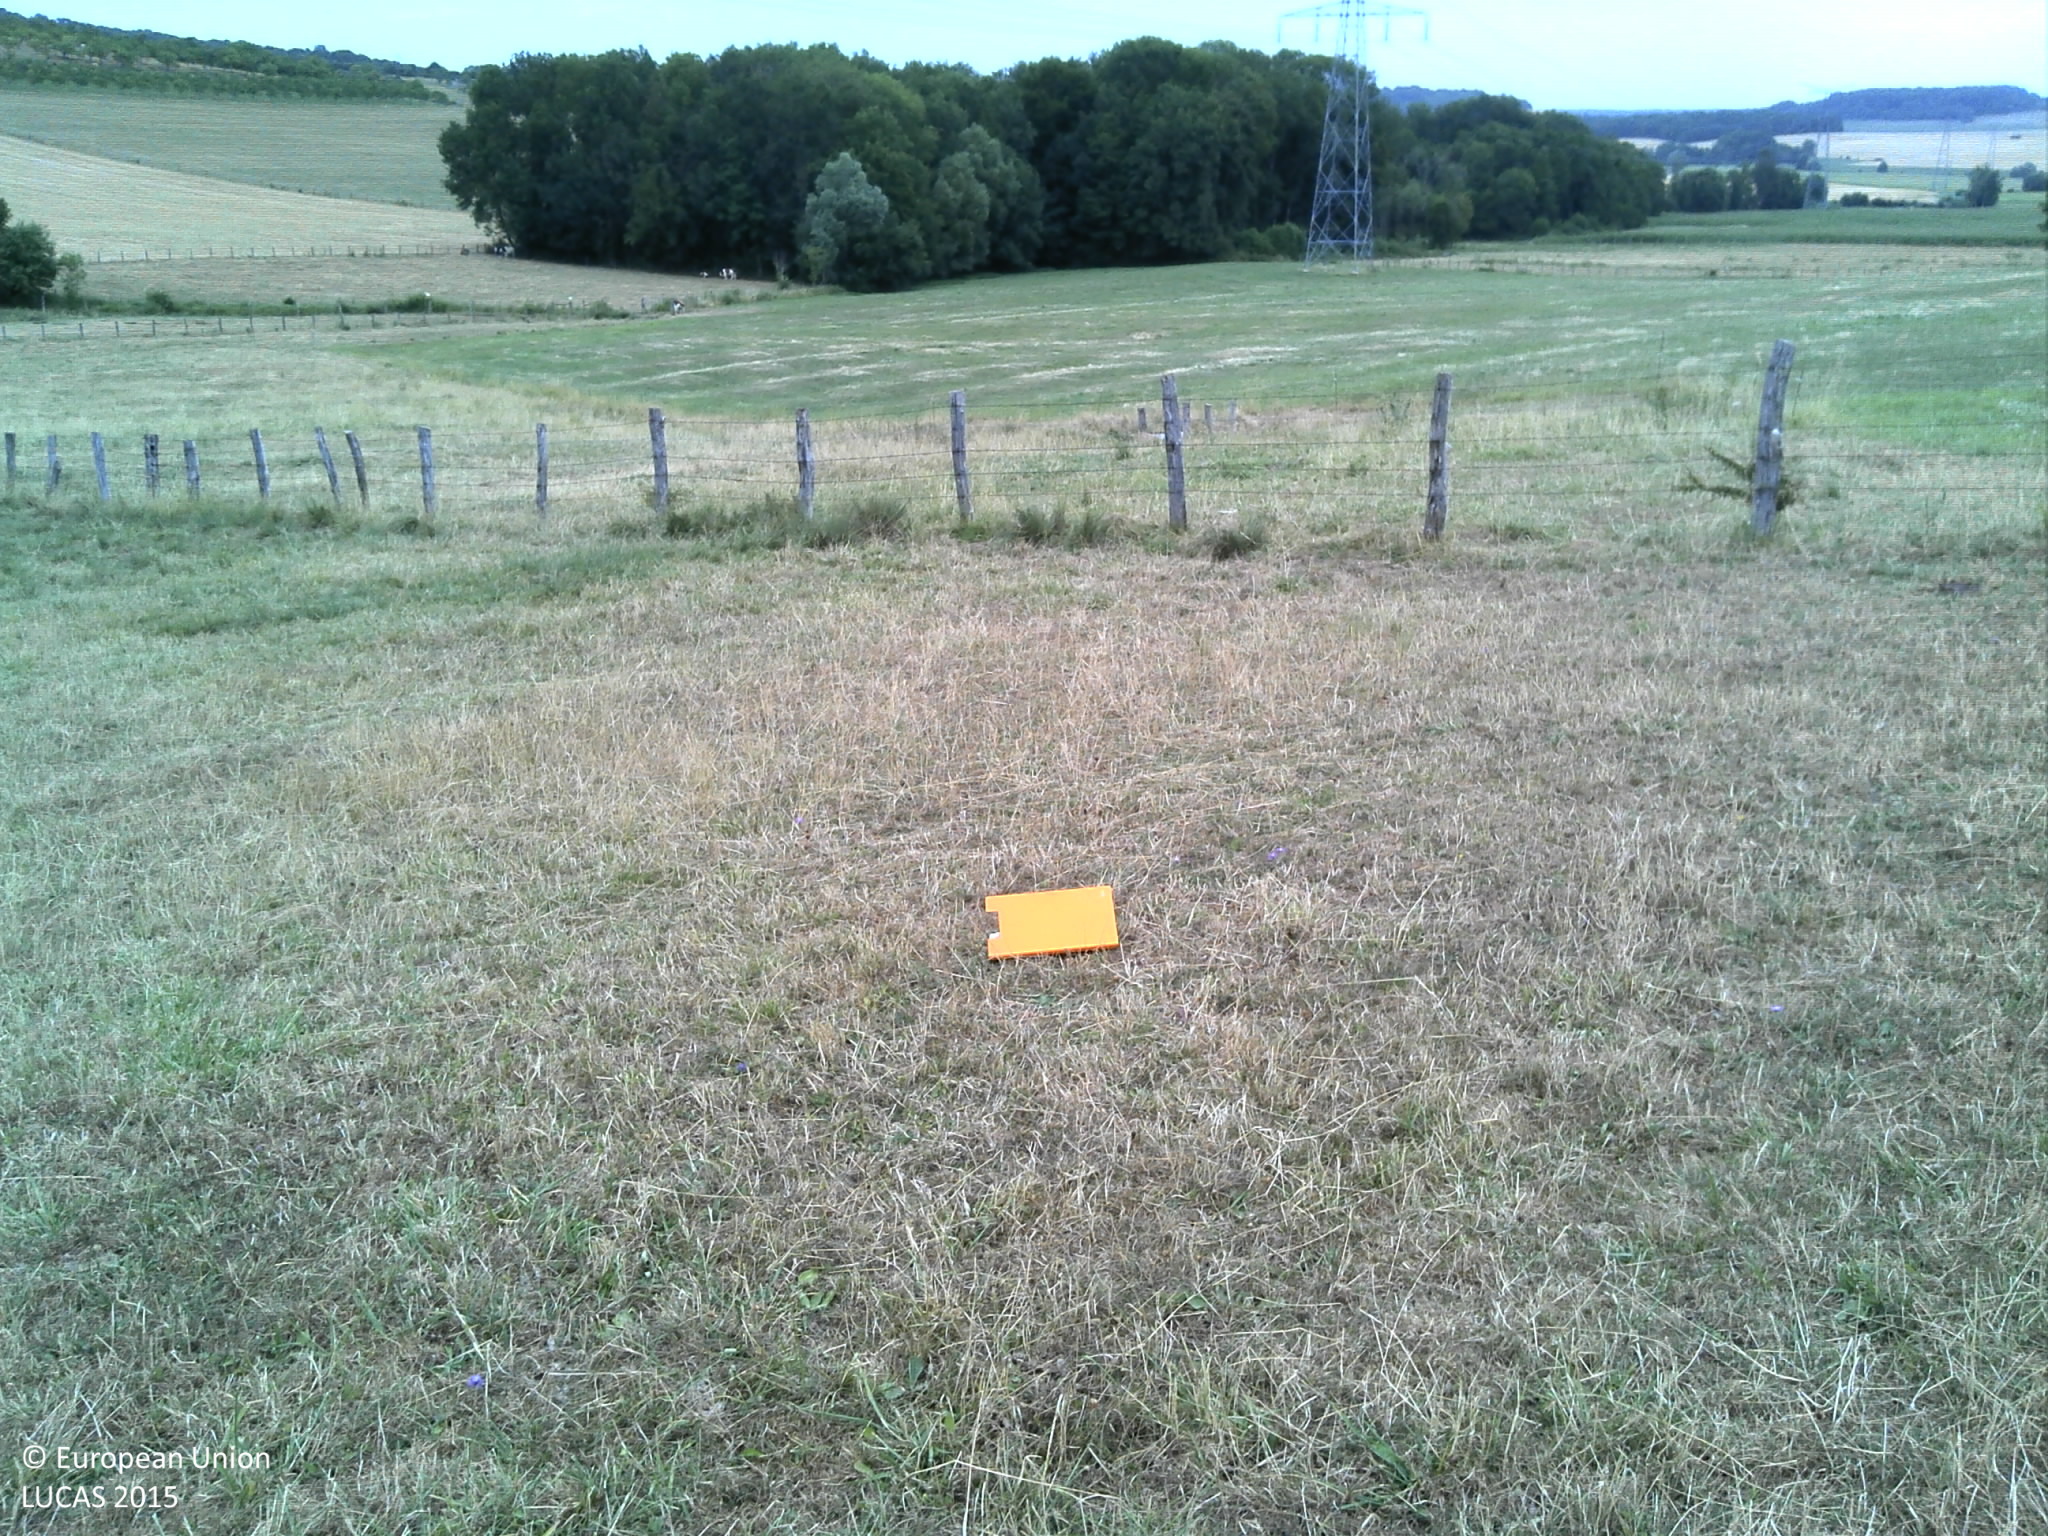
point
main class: Grassland
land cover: Grassland without tree/shrub cover
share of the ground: > 75 %
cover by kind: herbaceous plants 100 %
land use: Agriculture (excluding fallow land and kitchen gardens)
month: July
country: FR
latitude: 48.3224
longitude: 6.2646
